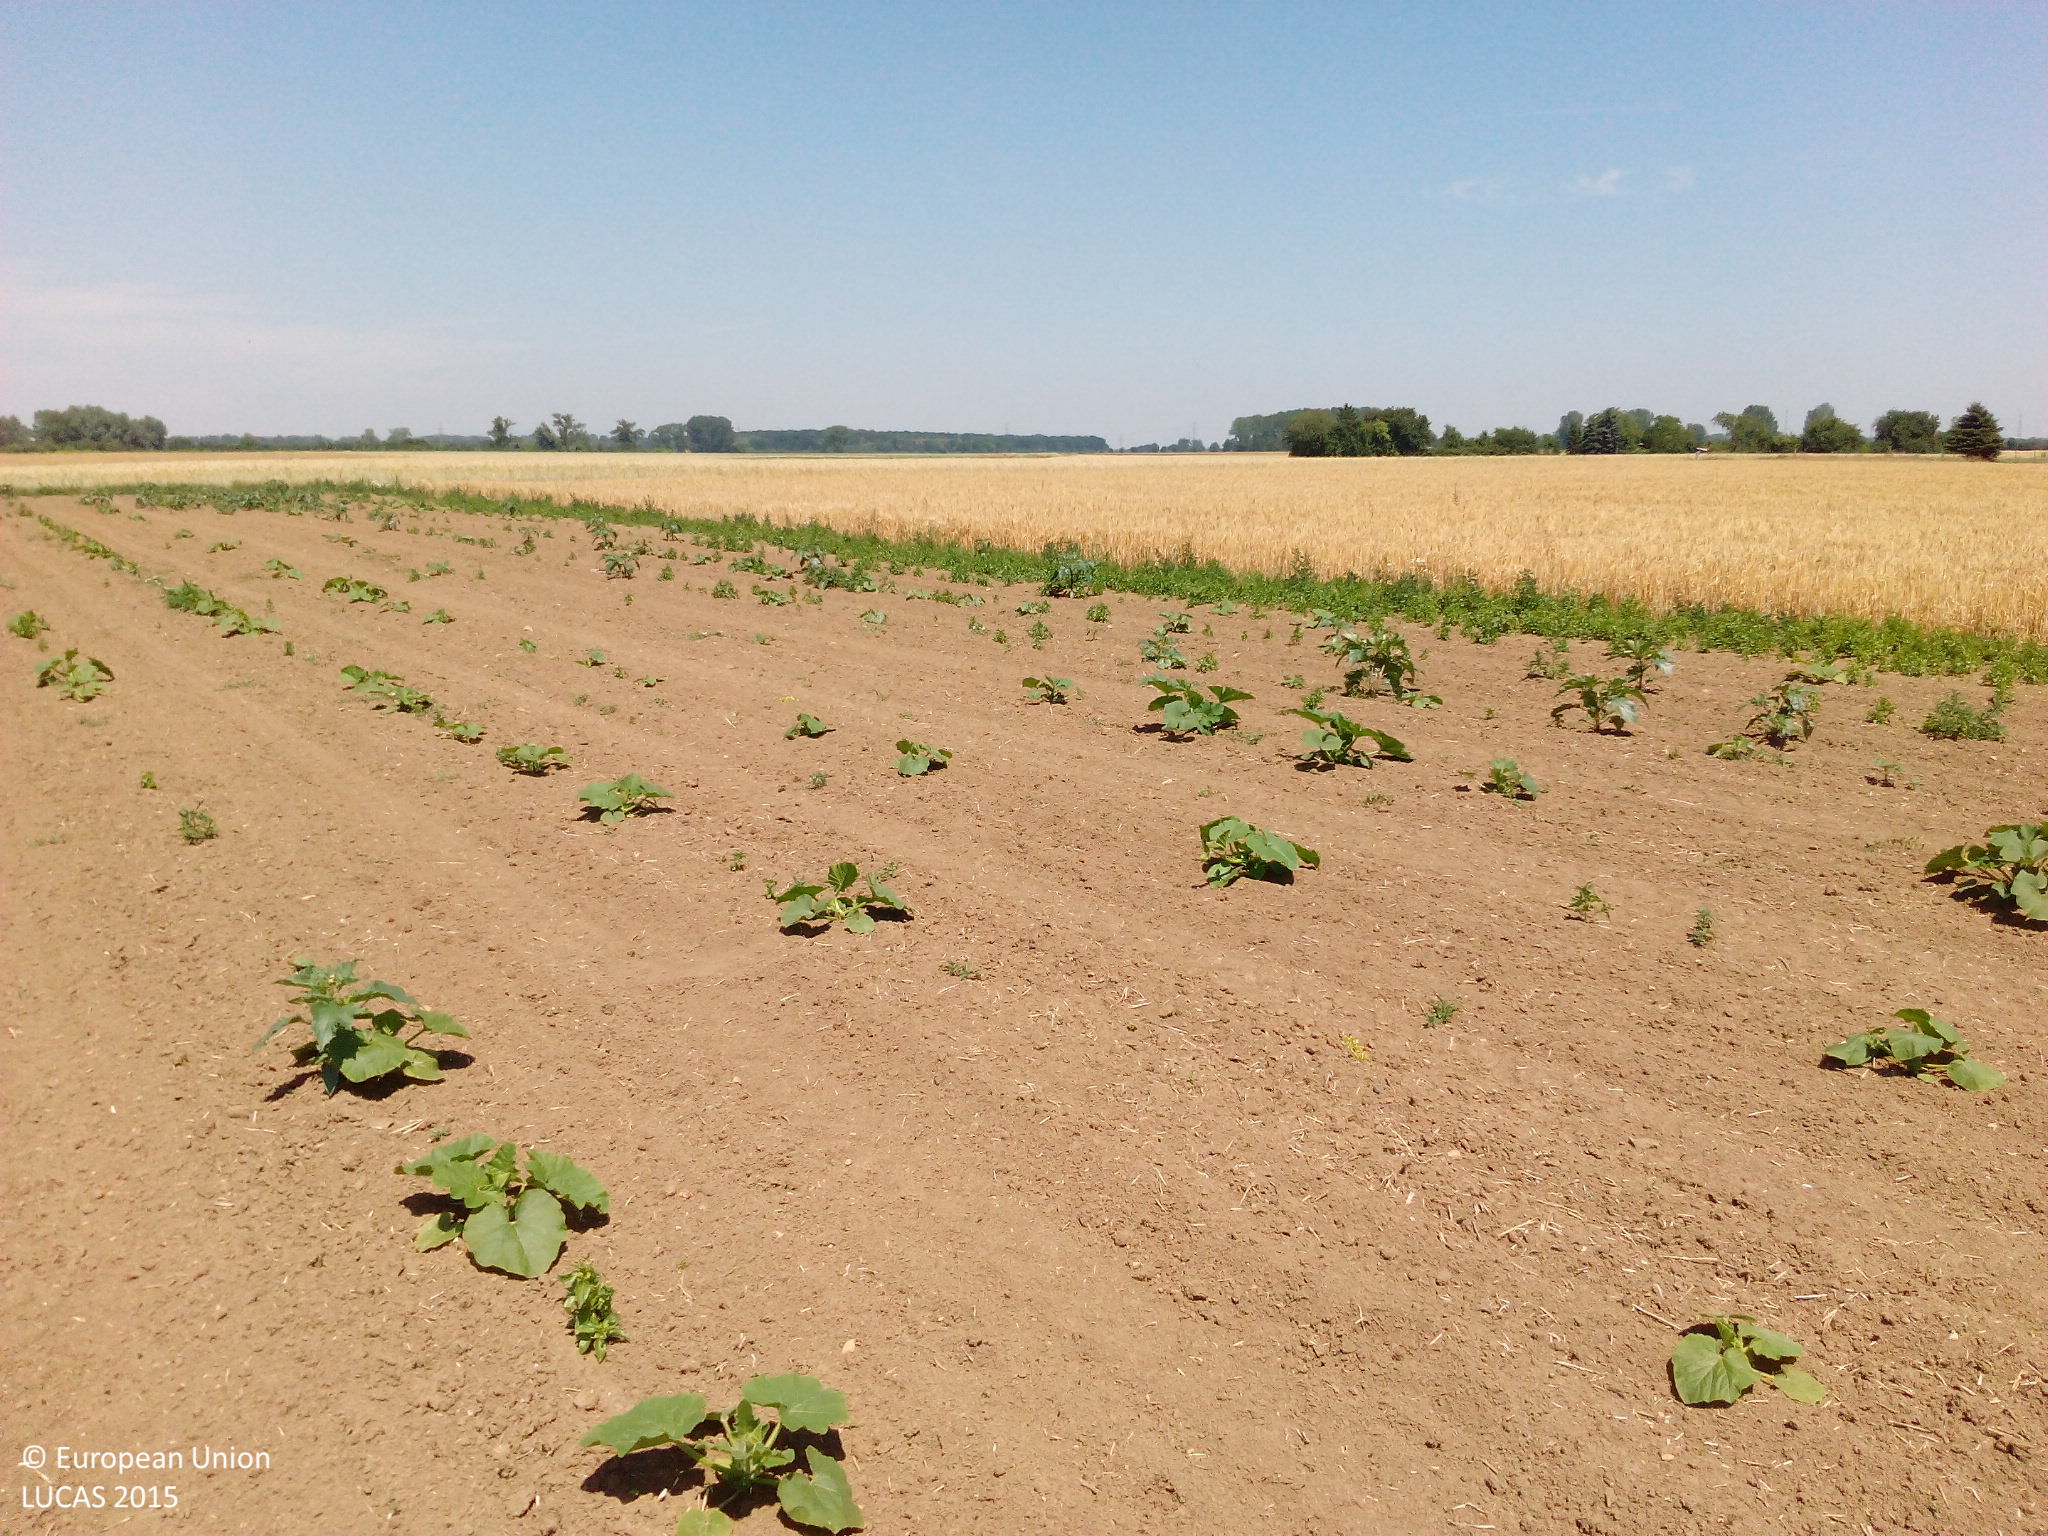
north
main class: Cropland
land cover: Other fresh vegetables
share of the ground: < 10 %
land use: Agriculture (excluding fallow land and kitchen gardens)
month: July
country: DE
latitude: 49.7972
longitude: 8.5417
